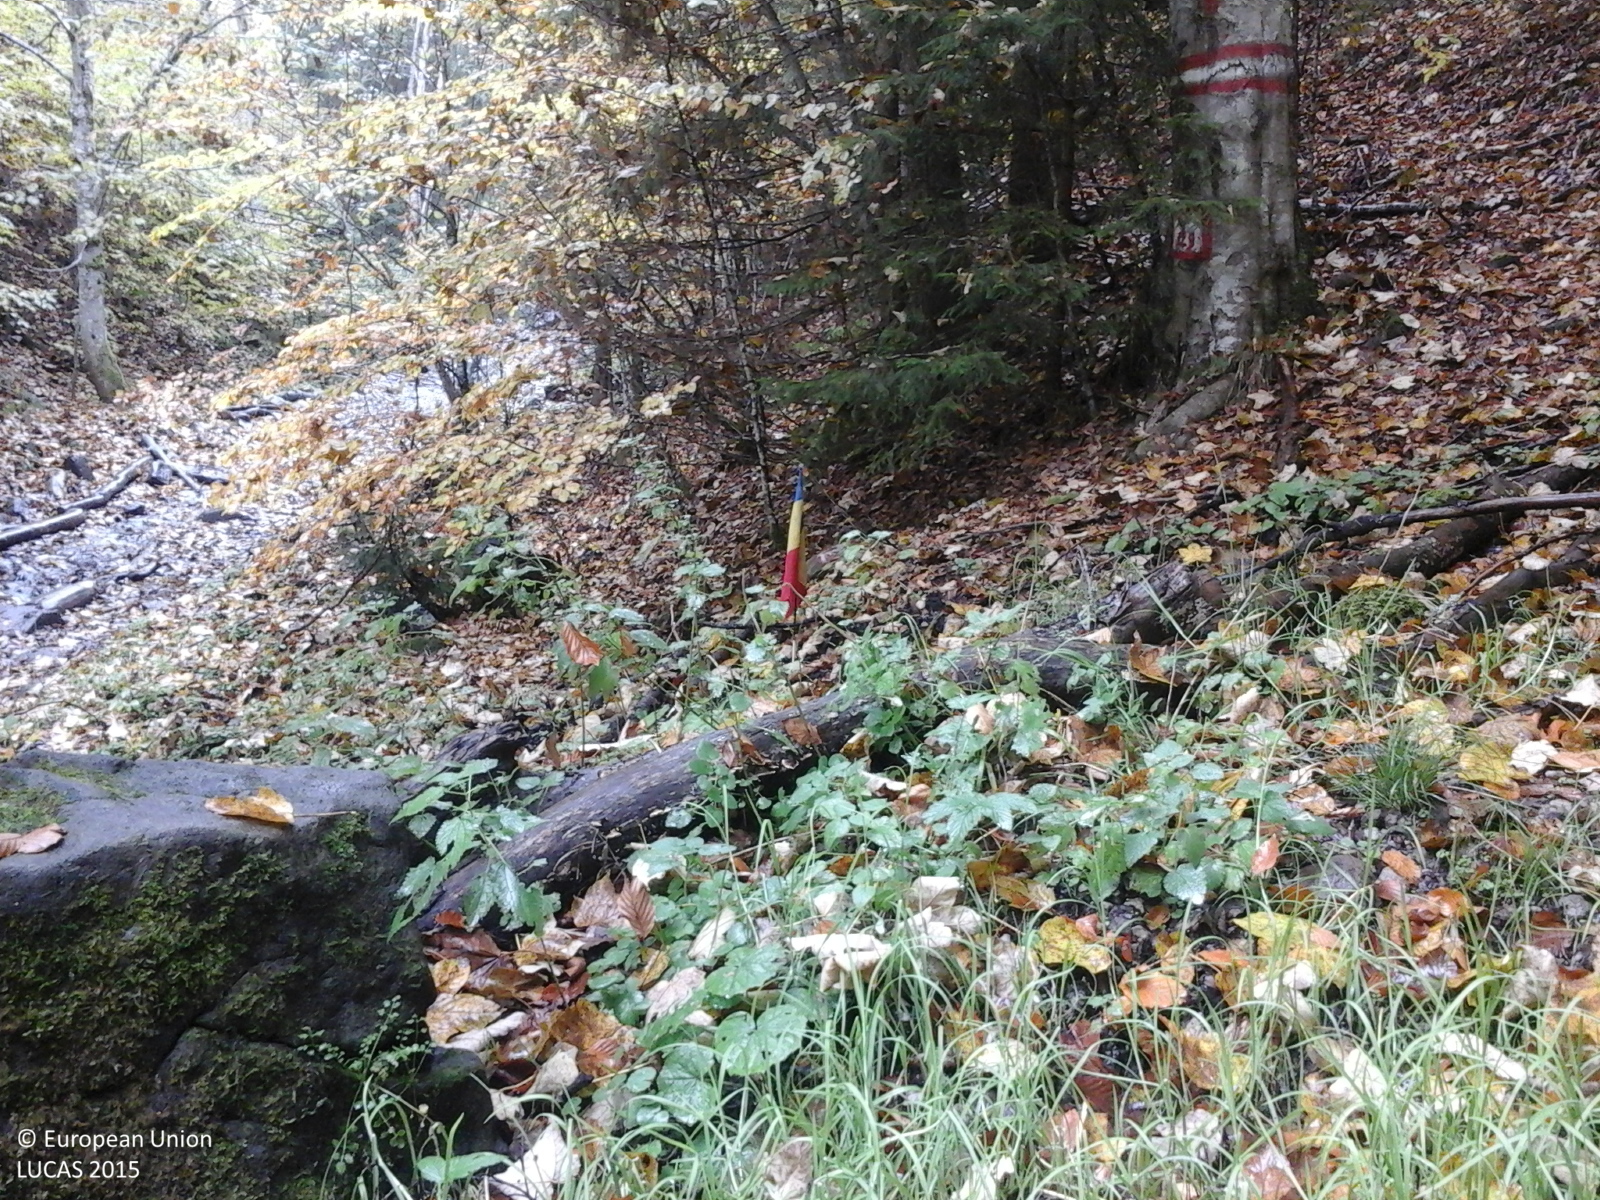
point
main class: Woodland
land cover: Broadleaved woodland
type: beech forest
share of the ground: > 75 %
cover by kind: broadleaved forest trees 100 %
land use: Forestry
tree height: > 5 m
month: October
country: RO
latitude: 46.7764
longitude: 25.2045
